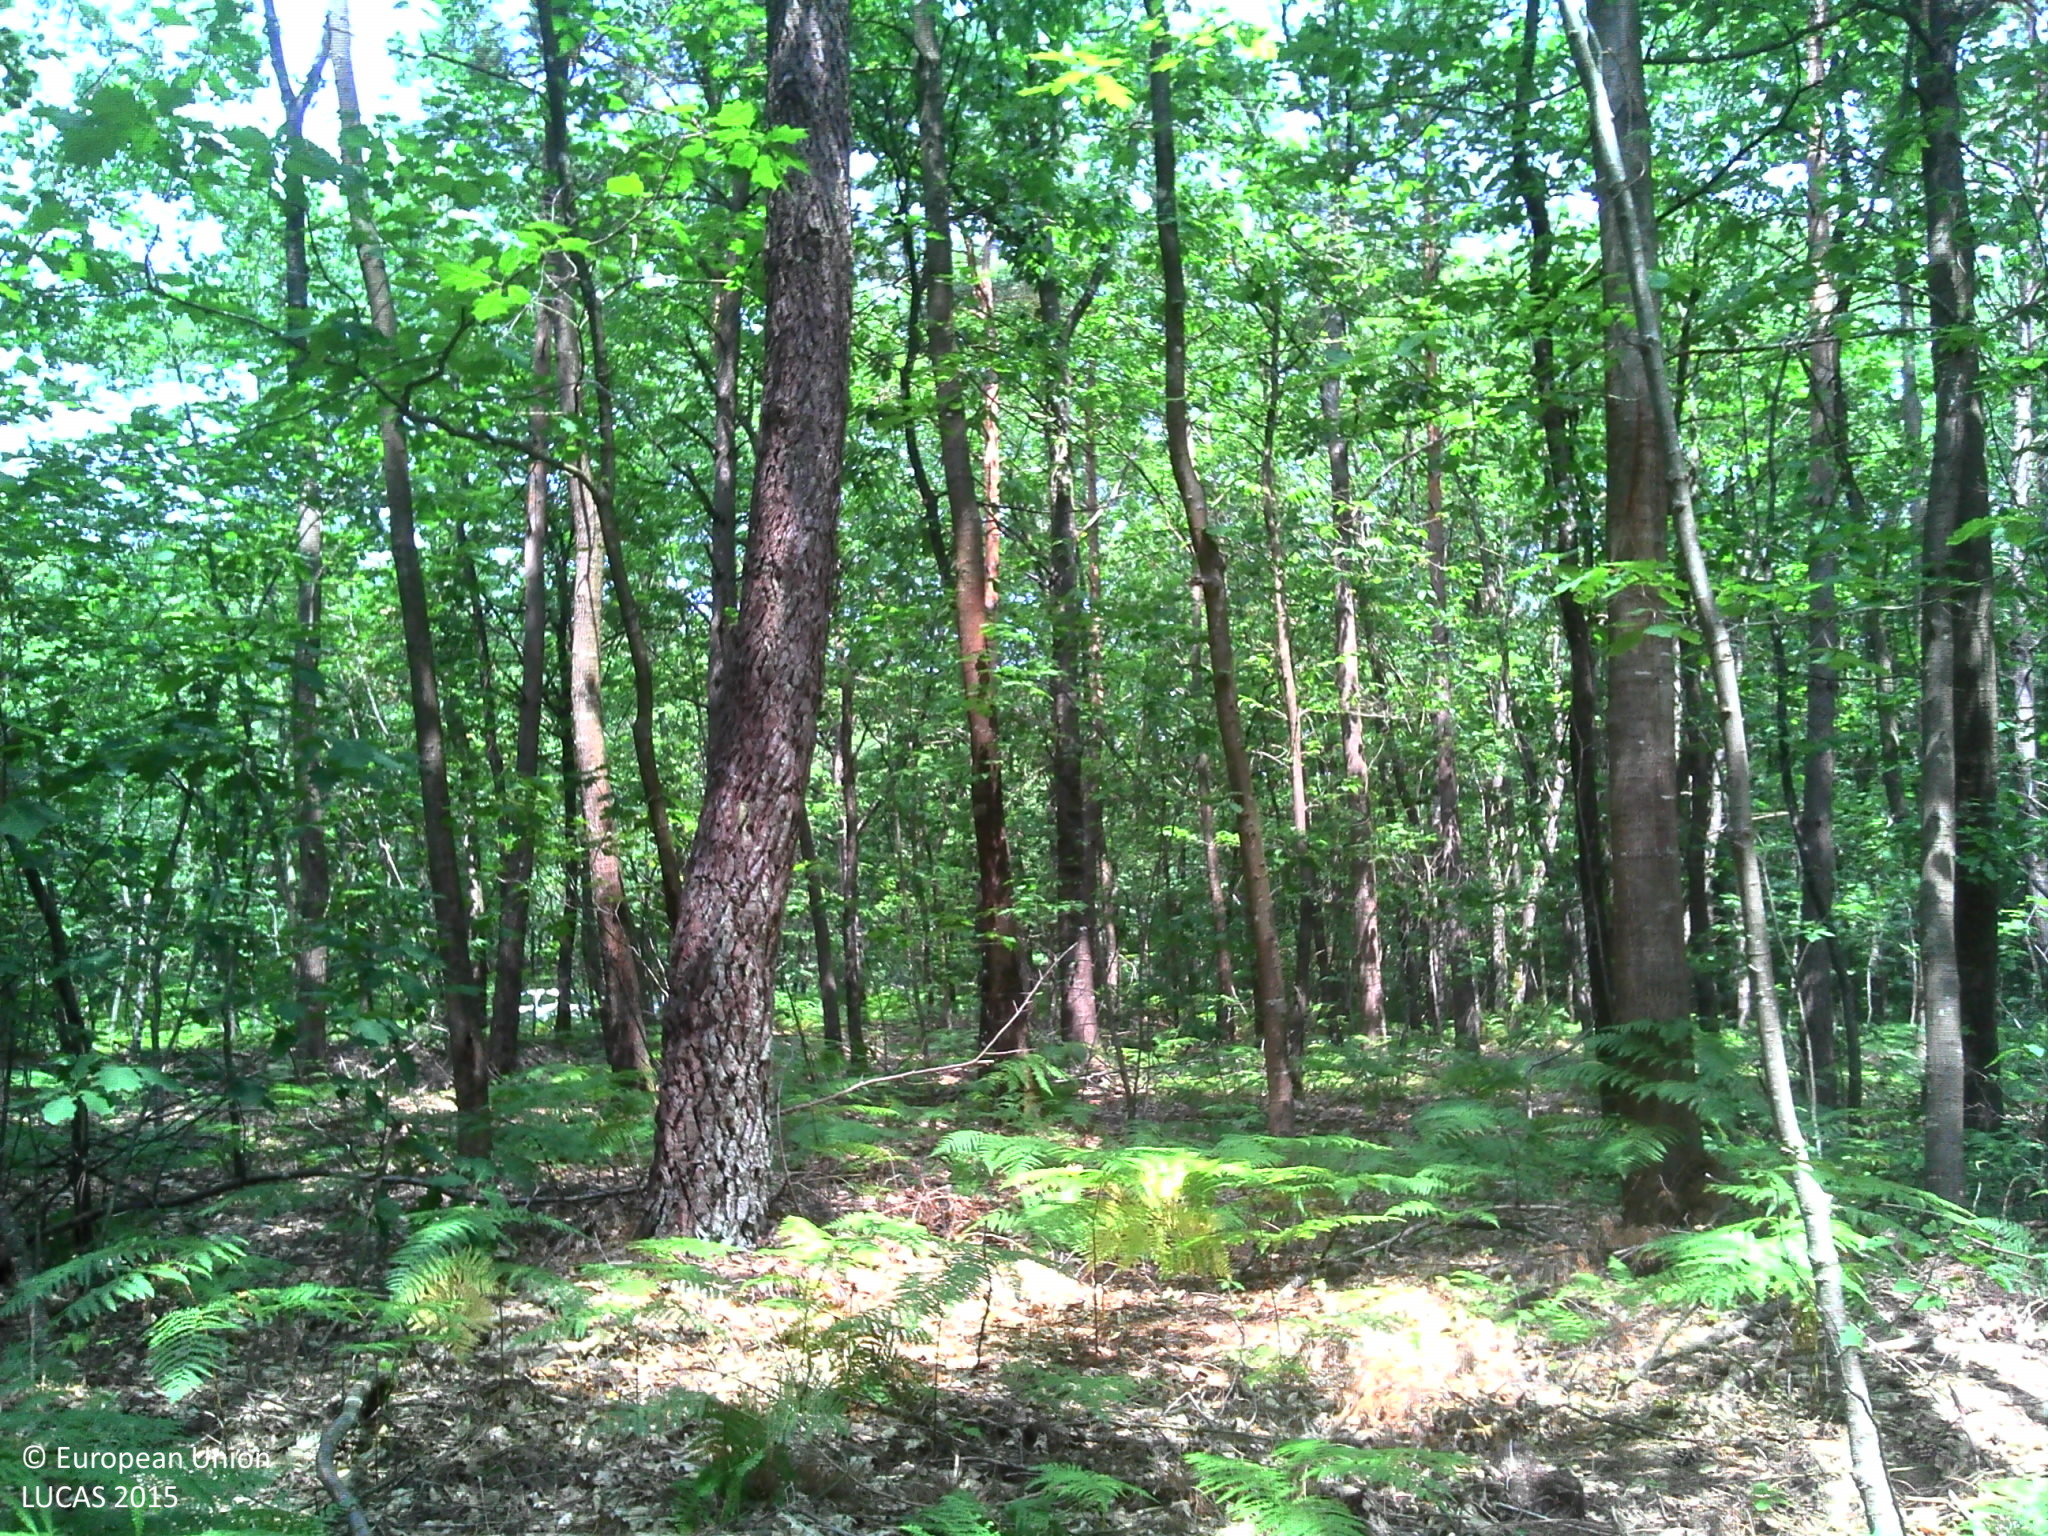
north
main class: Woodland
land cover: Pine dominated mixed woodland
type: hemiboreal forest and nemoral coniferous forest and mixed broadleaved-coniferous forest
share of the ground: > 75 %
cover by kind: broadleaved forest trees 50 %, coniferous forest trees 25 %, herbaceous plants 15 %, shrubs 10 %
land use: Forestry
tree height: > 5 m
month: July
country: FR
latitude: 47.7435
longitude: 0.3336
